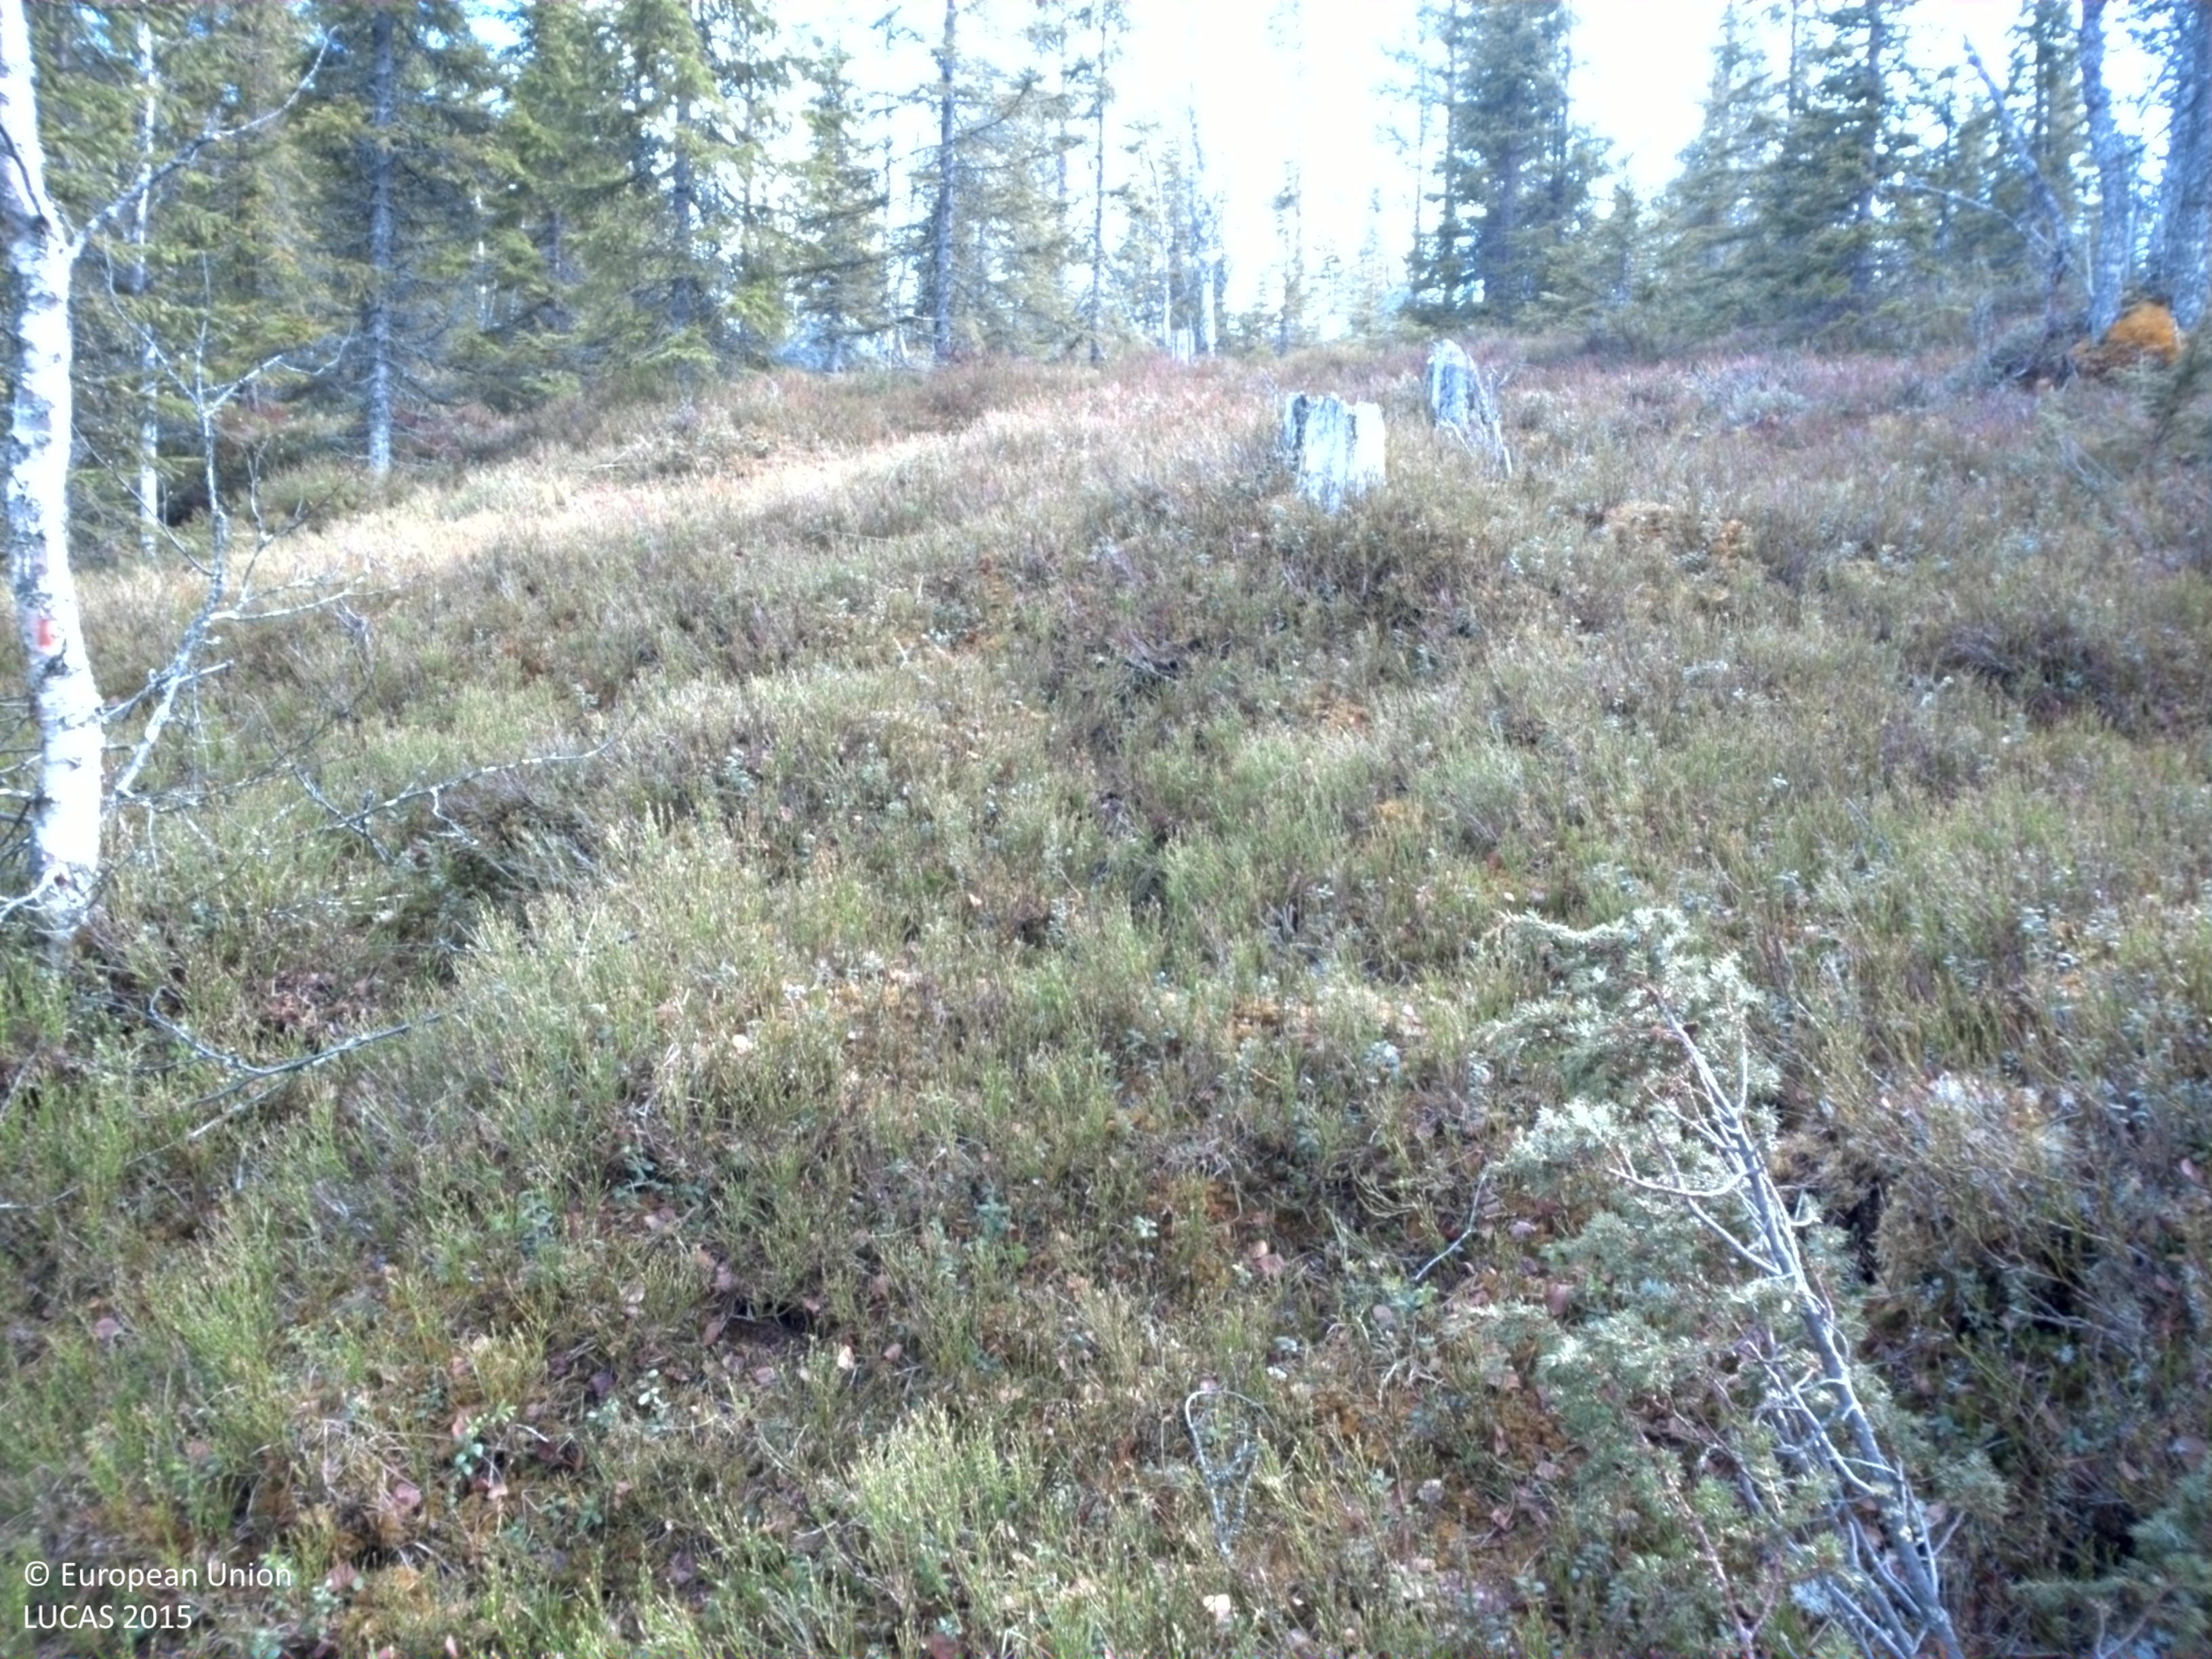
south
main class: Woodland
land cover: Spruce dominated coniferous woodland
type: boreal forest
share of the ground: 10 - 25 %
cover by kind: herbaceous plants 45 %, coniferous forest trees 25 %, shrubs 15 %, lichens and mosses 10 %, broadleaved forest trees 5 %
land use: Forestry
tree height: > 5 m
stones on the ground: 10 - 25 %
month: May
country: SE
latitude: 64.1952
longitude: 18.0203
